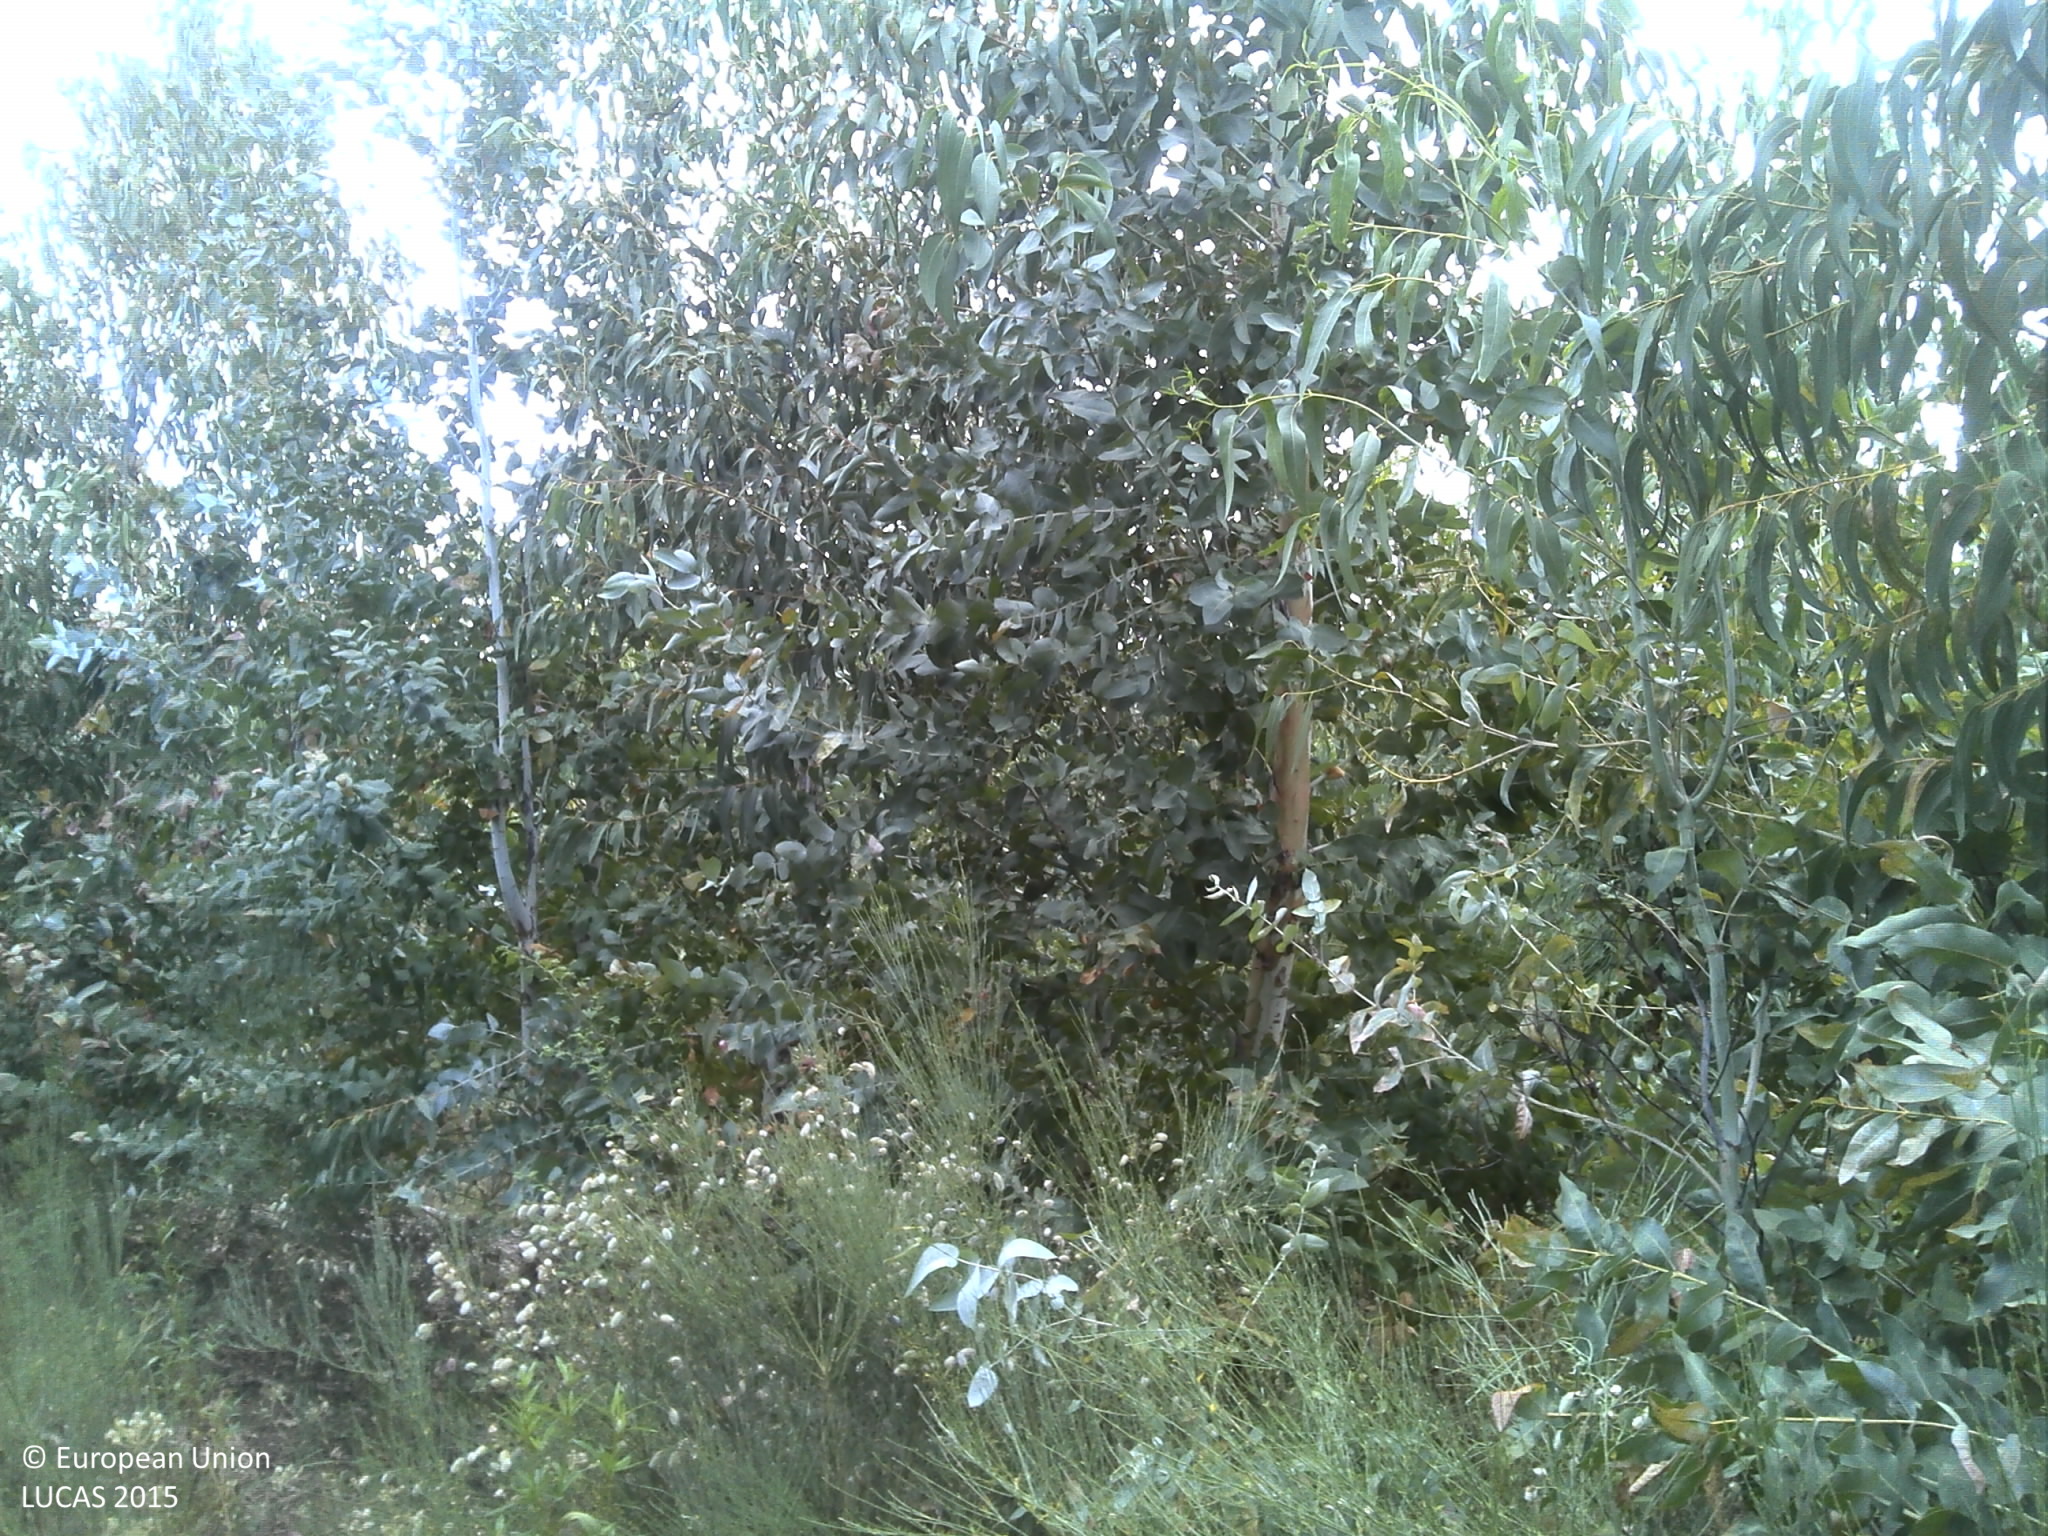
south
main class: Woodland
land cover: Broadleaved woodland
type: exotic forest
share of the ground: 25 - 50 %
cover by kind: broadleaved forest trees 40 %, unconsolidated bare surface 35 %, shrubs 25 %
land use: Forestry
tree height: > 5 m
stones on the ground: 10 - 25 %
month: June
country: PT
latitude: 40.2689
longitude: -7.1860
